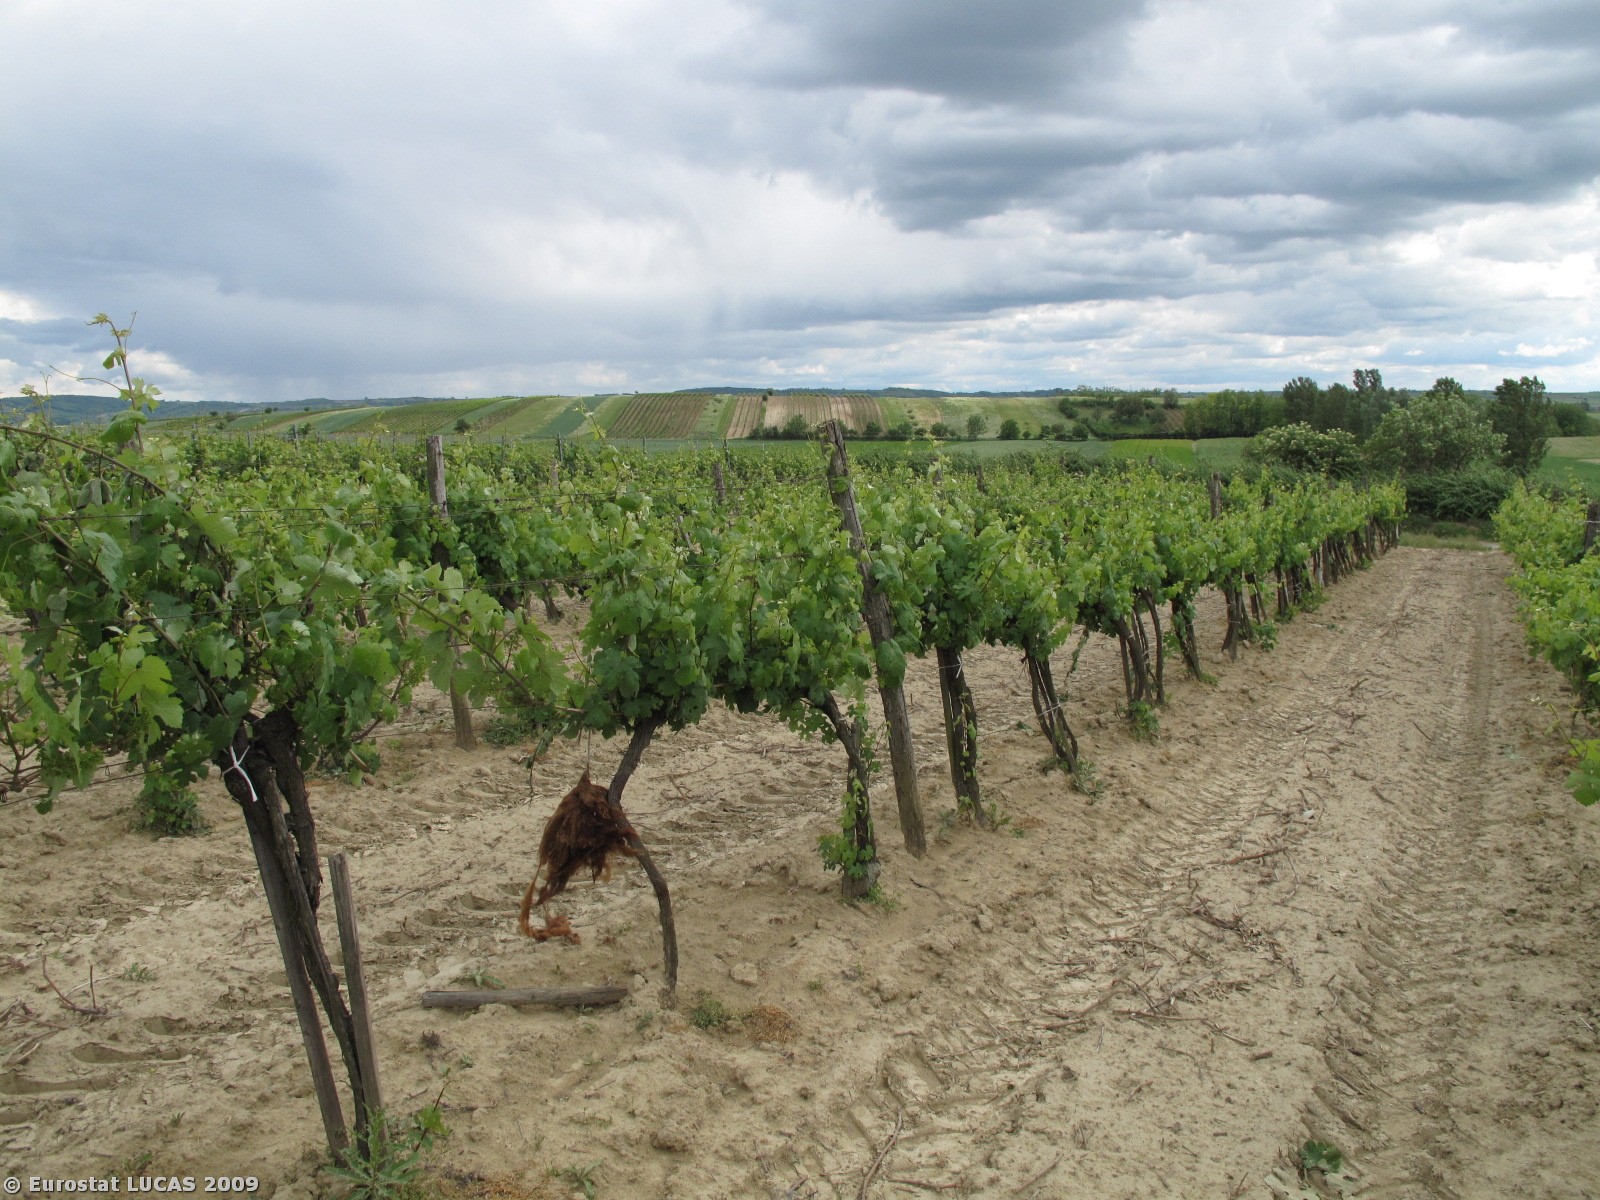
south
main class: Cropland
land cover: Vineyards
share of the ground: 10 - 25 %
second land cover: Bare land
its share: > 75 %
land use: Agriculture (excluding fallow land and kitchen gardens)
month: May
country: AT
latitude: 48.7247
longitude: 16.0540
